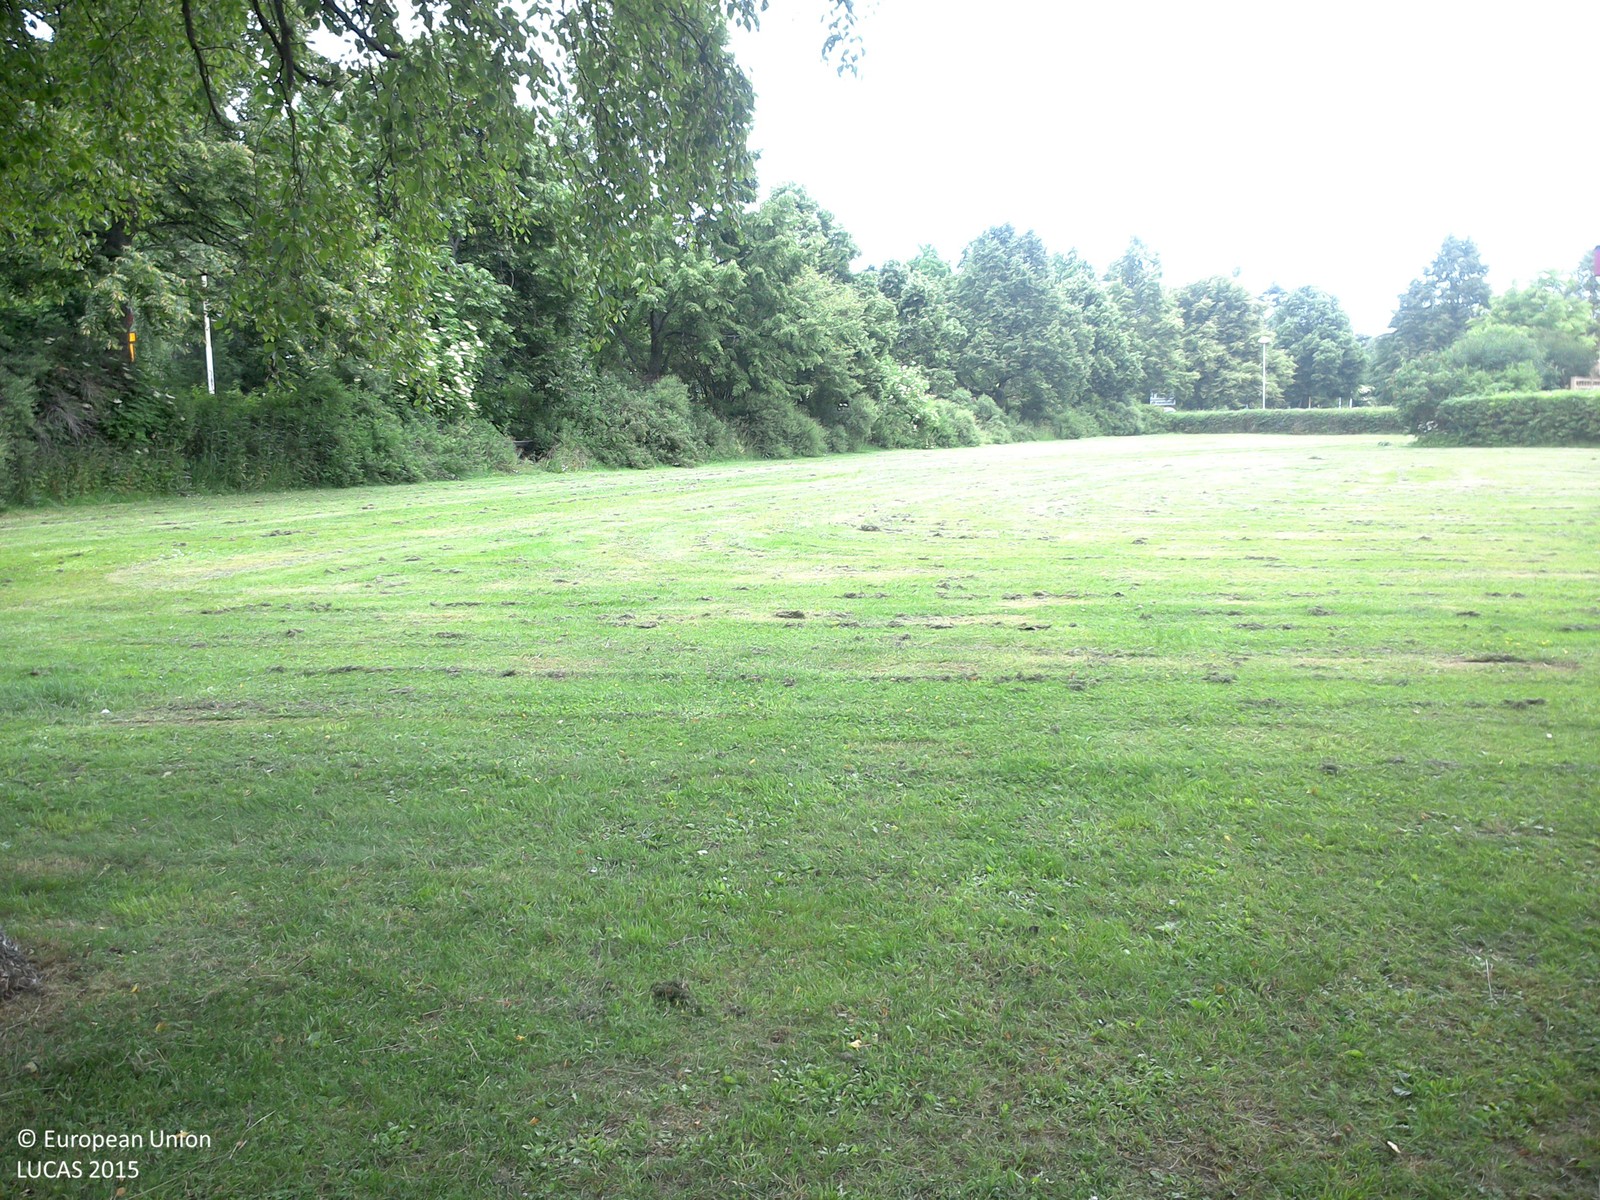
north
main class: Woodland
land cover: Broadleaved woodland
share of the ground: < 10 %
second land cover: Grassland without tree/shrub cover
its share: > 75 %
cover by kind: herbaceous plants 75 %, broadleaved forest trees 25 %
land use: Amenities, museums, leisure
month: June
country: SE
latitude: 58.4113
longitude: 15.5572
